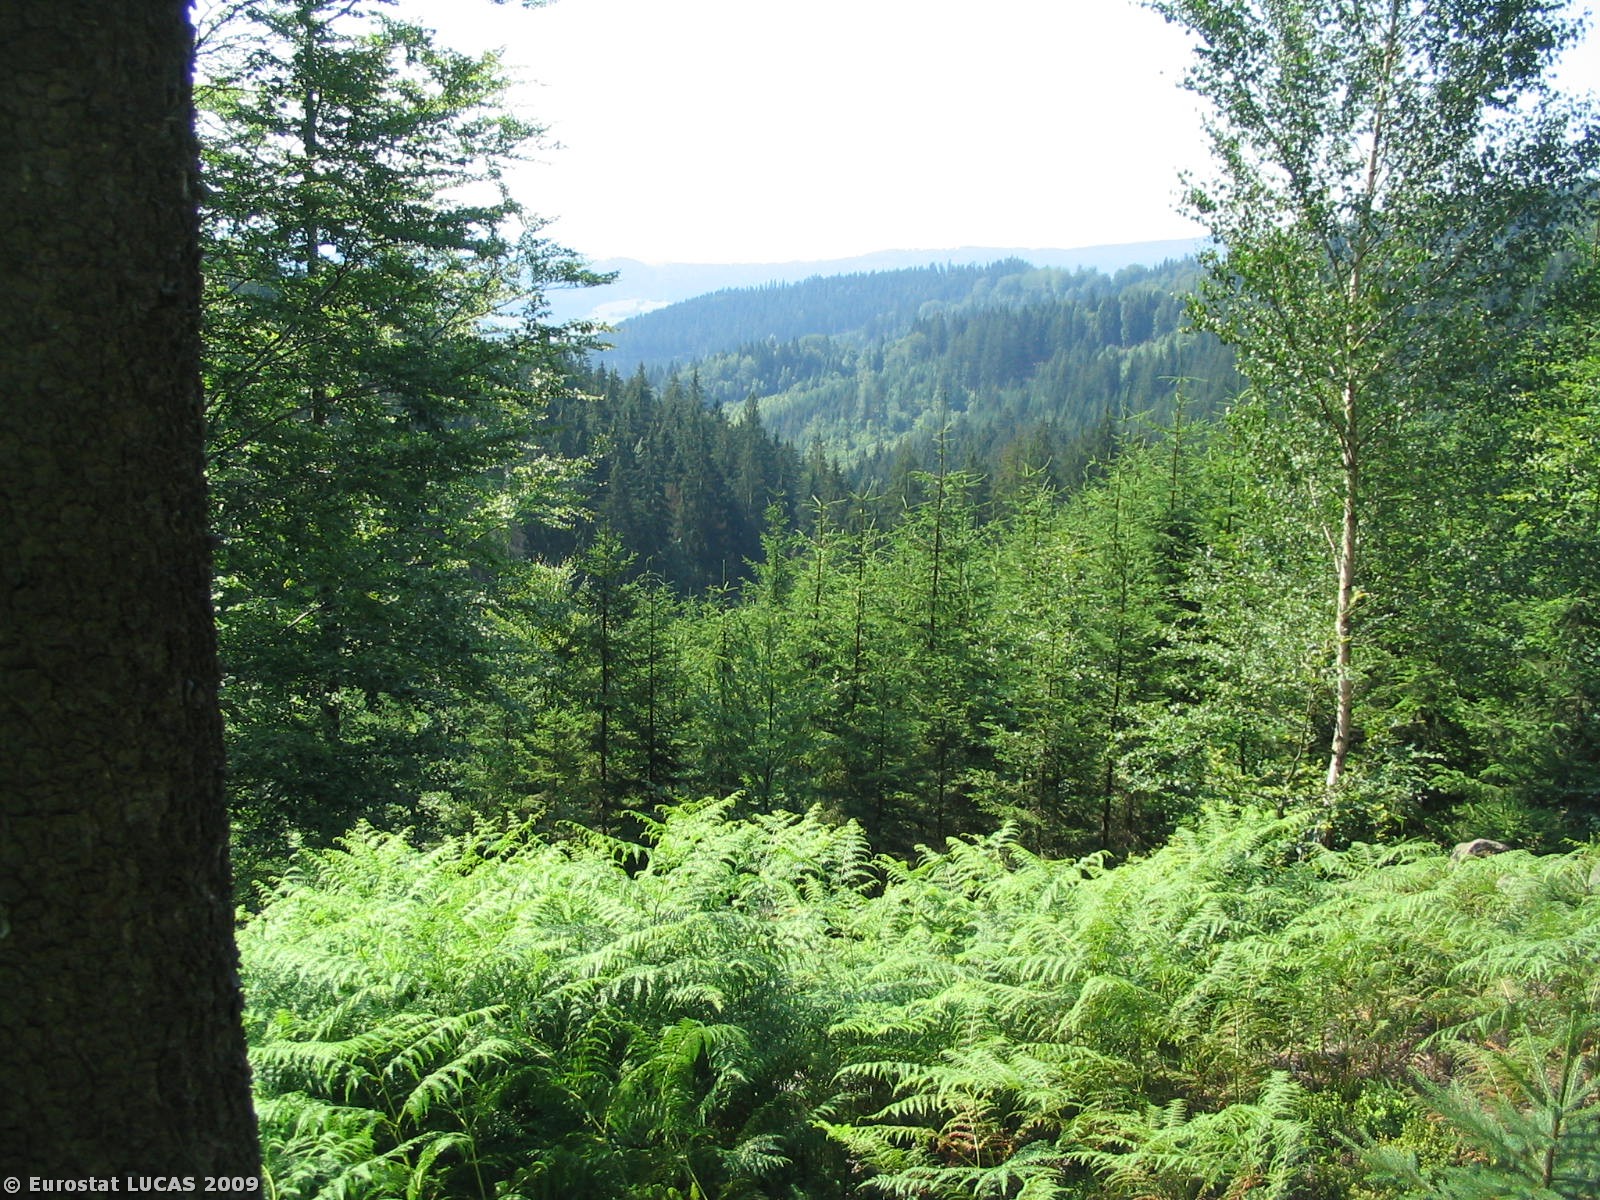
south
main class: Woodland
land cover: Mixed woodland
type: mountainous beech forest
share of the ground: > 75 %
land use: Forestry
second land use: Nature reserves
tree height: > 5 m
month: July
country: CZ
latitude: 49.5876
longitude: 18.8326
